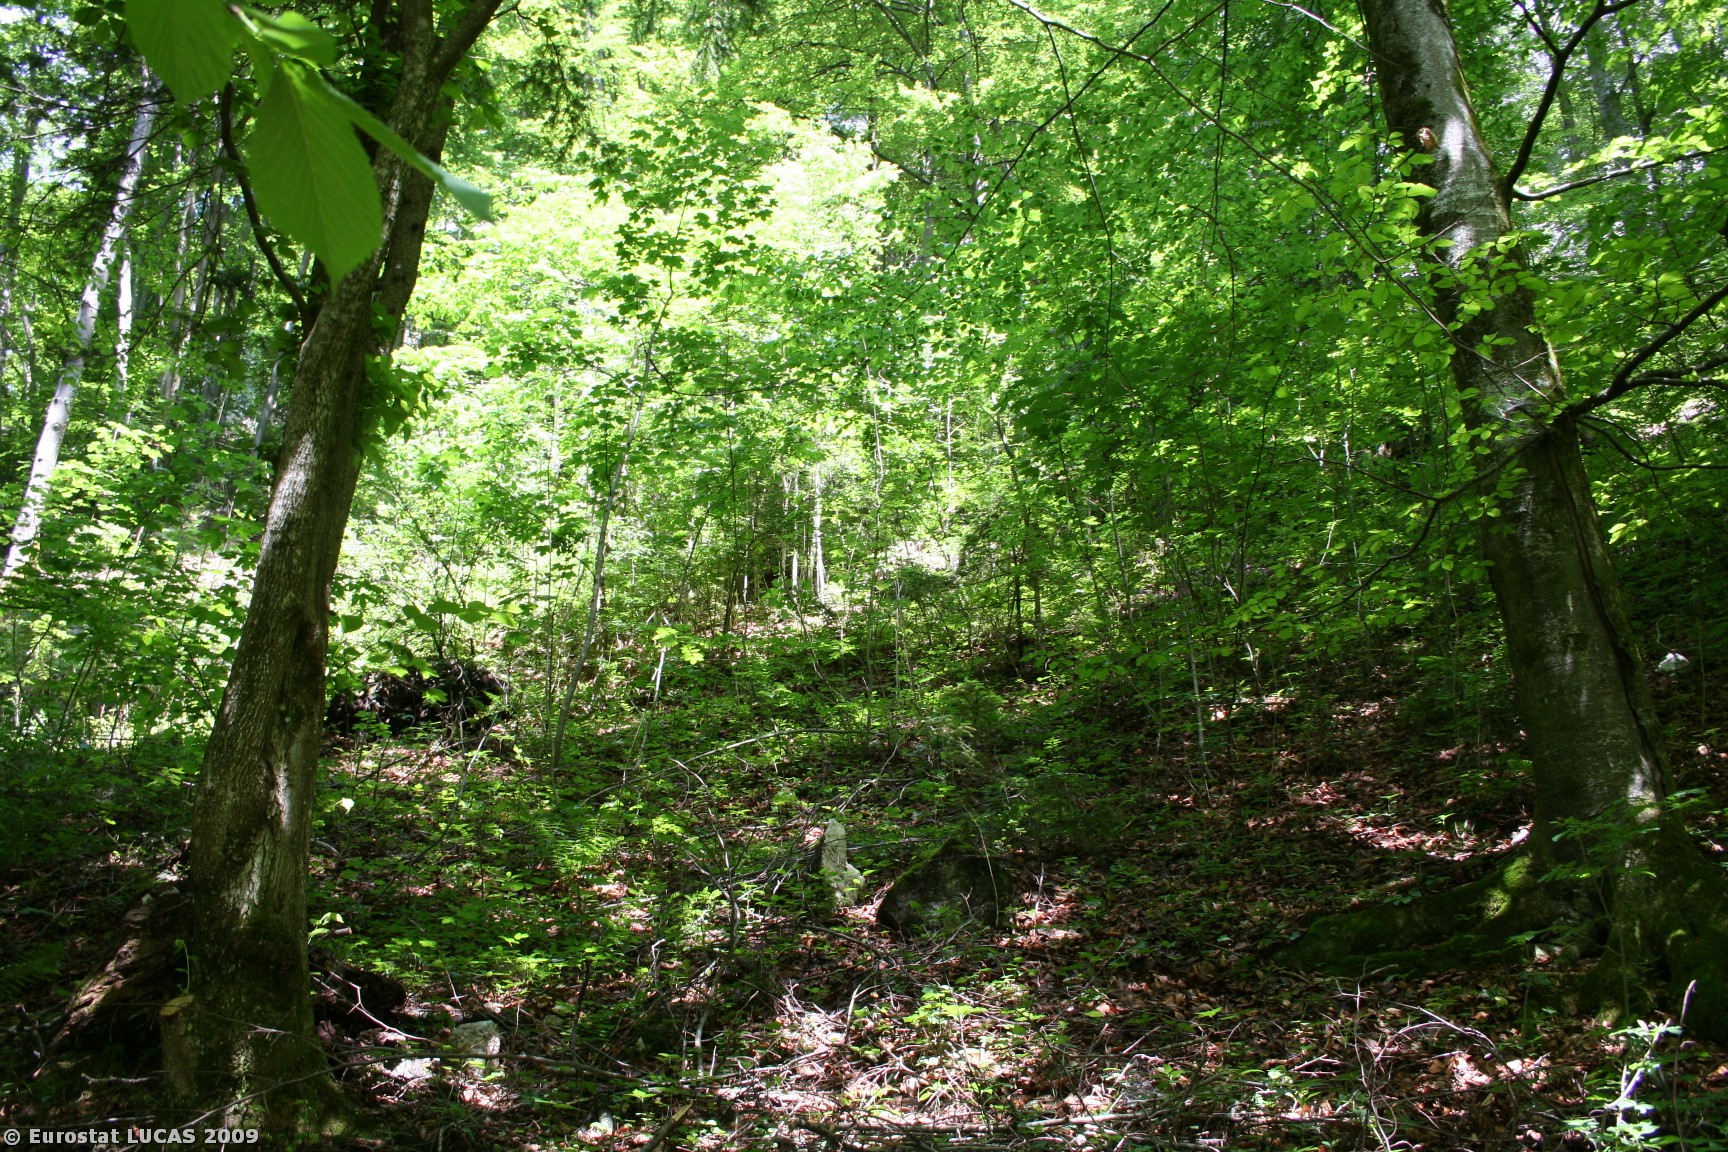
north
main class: Woodland
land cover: Mixed woodland
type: hemiboreal forest and nemoral coniferous forest and mixed broadleaved-coniferous forest
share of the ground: > 75 %
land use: Forestry
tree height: > 5 m
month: May
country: AT
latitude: 47.6007
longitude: 13.2039
